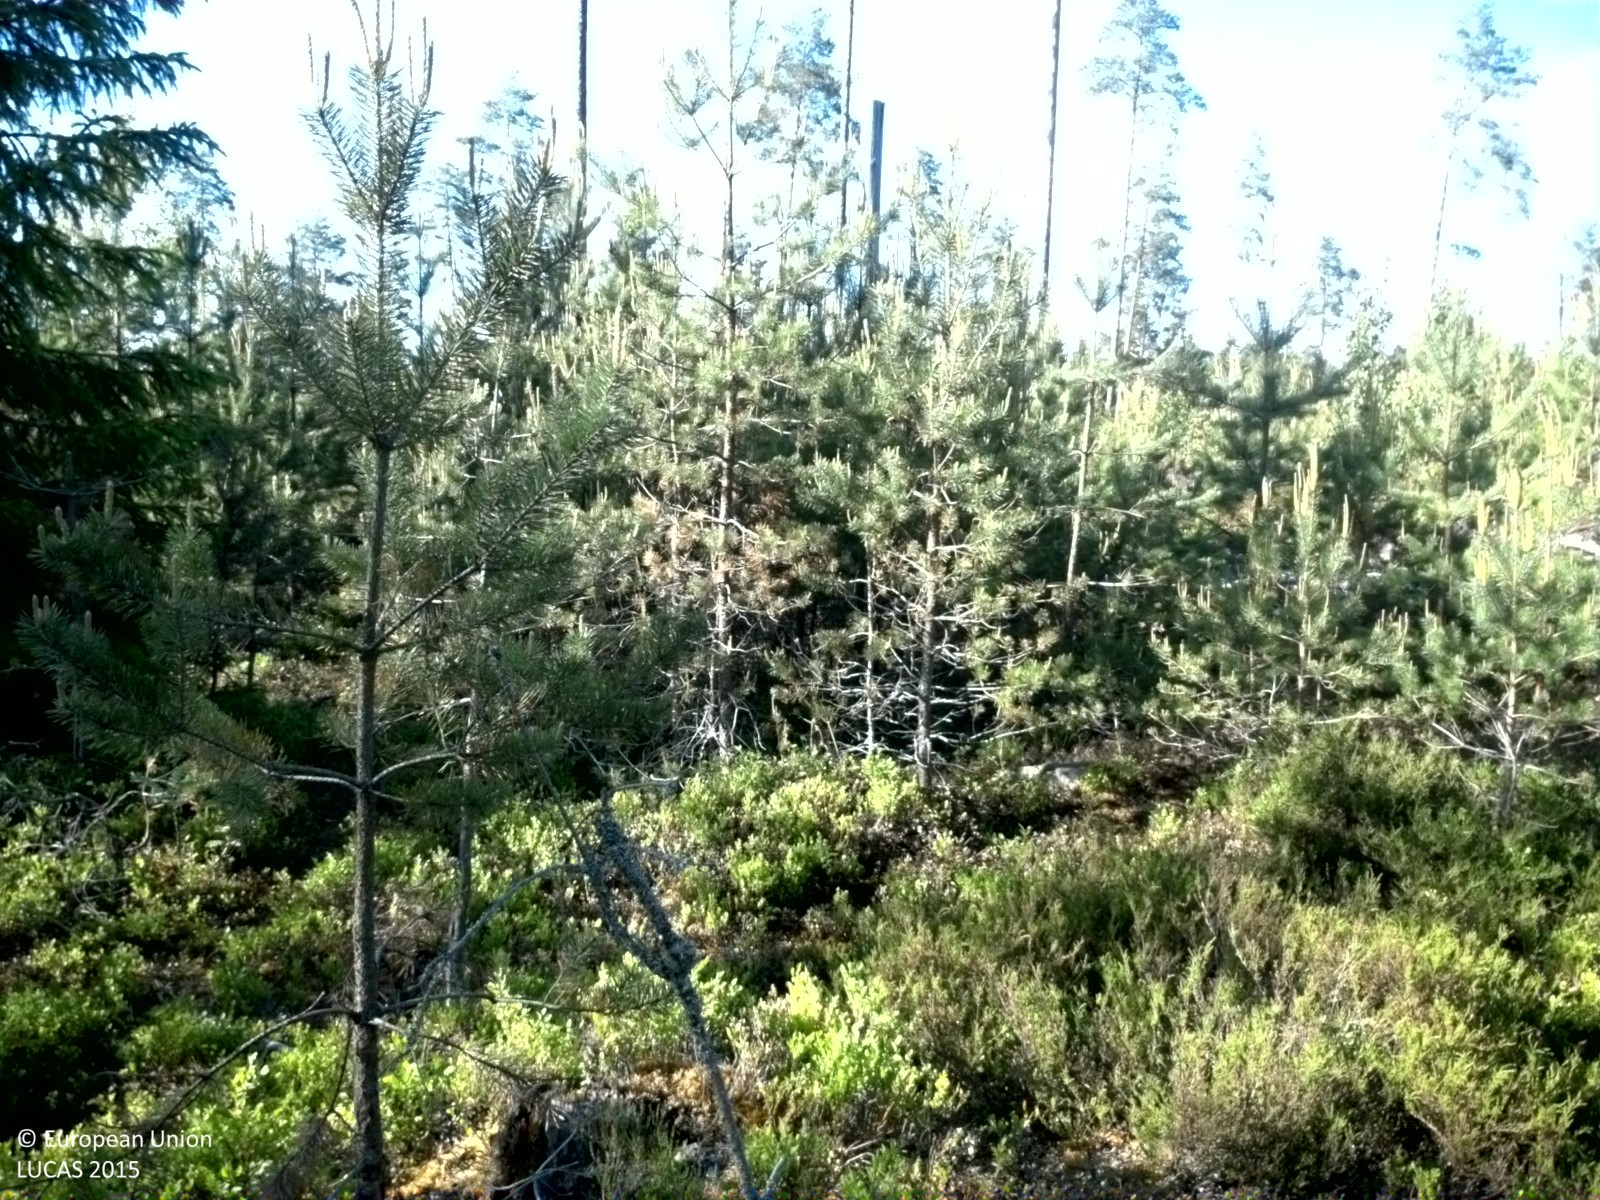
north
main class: Woodland
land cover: Pine dominated coniferous woodland
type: boreal forest
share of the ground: 25 - 50 %
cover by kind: coniferous forest trees 40 %, shrubs 25 %, broadleaved forest trees 10 %, herbaceous plants 10 %, consolidated bare surface 10 %
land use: Forestry
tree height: < 5 m
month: June
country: SE
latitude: 60.1539
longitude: 17.6489
